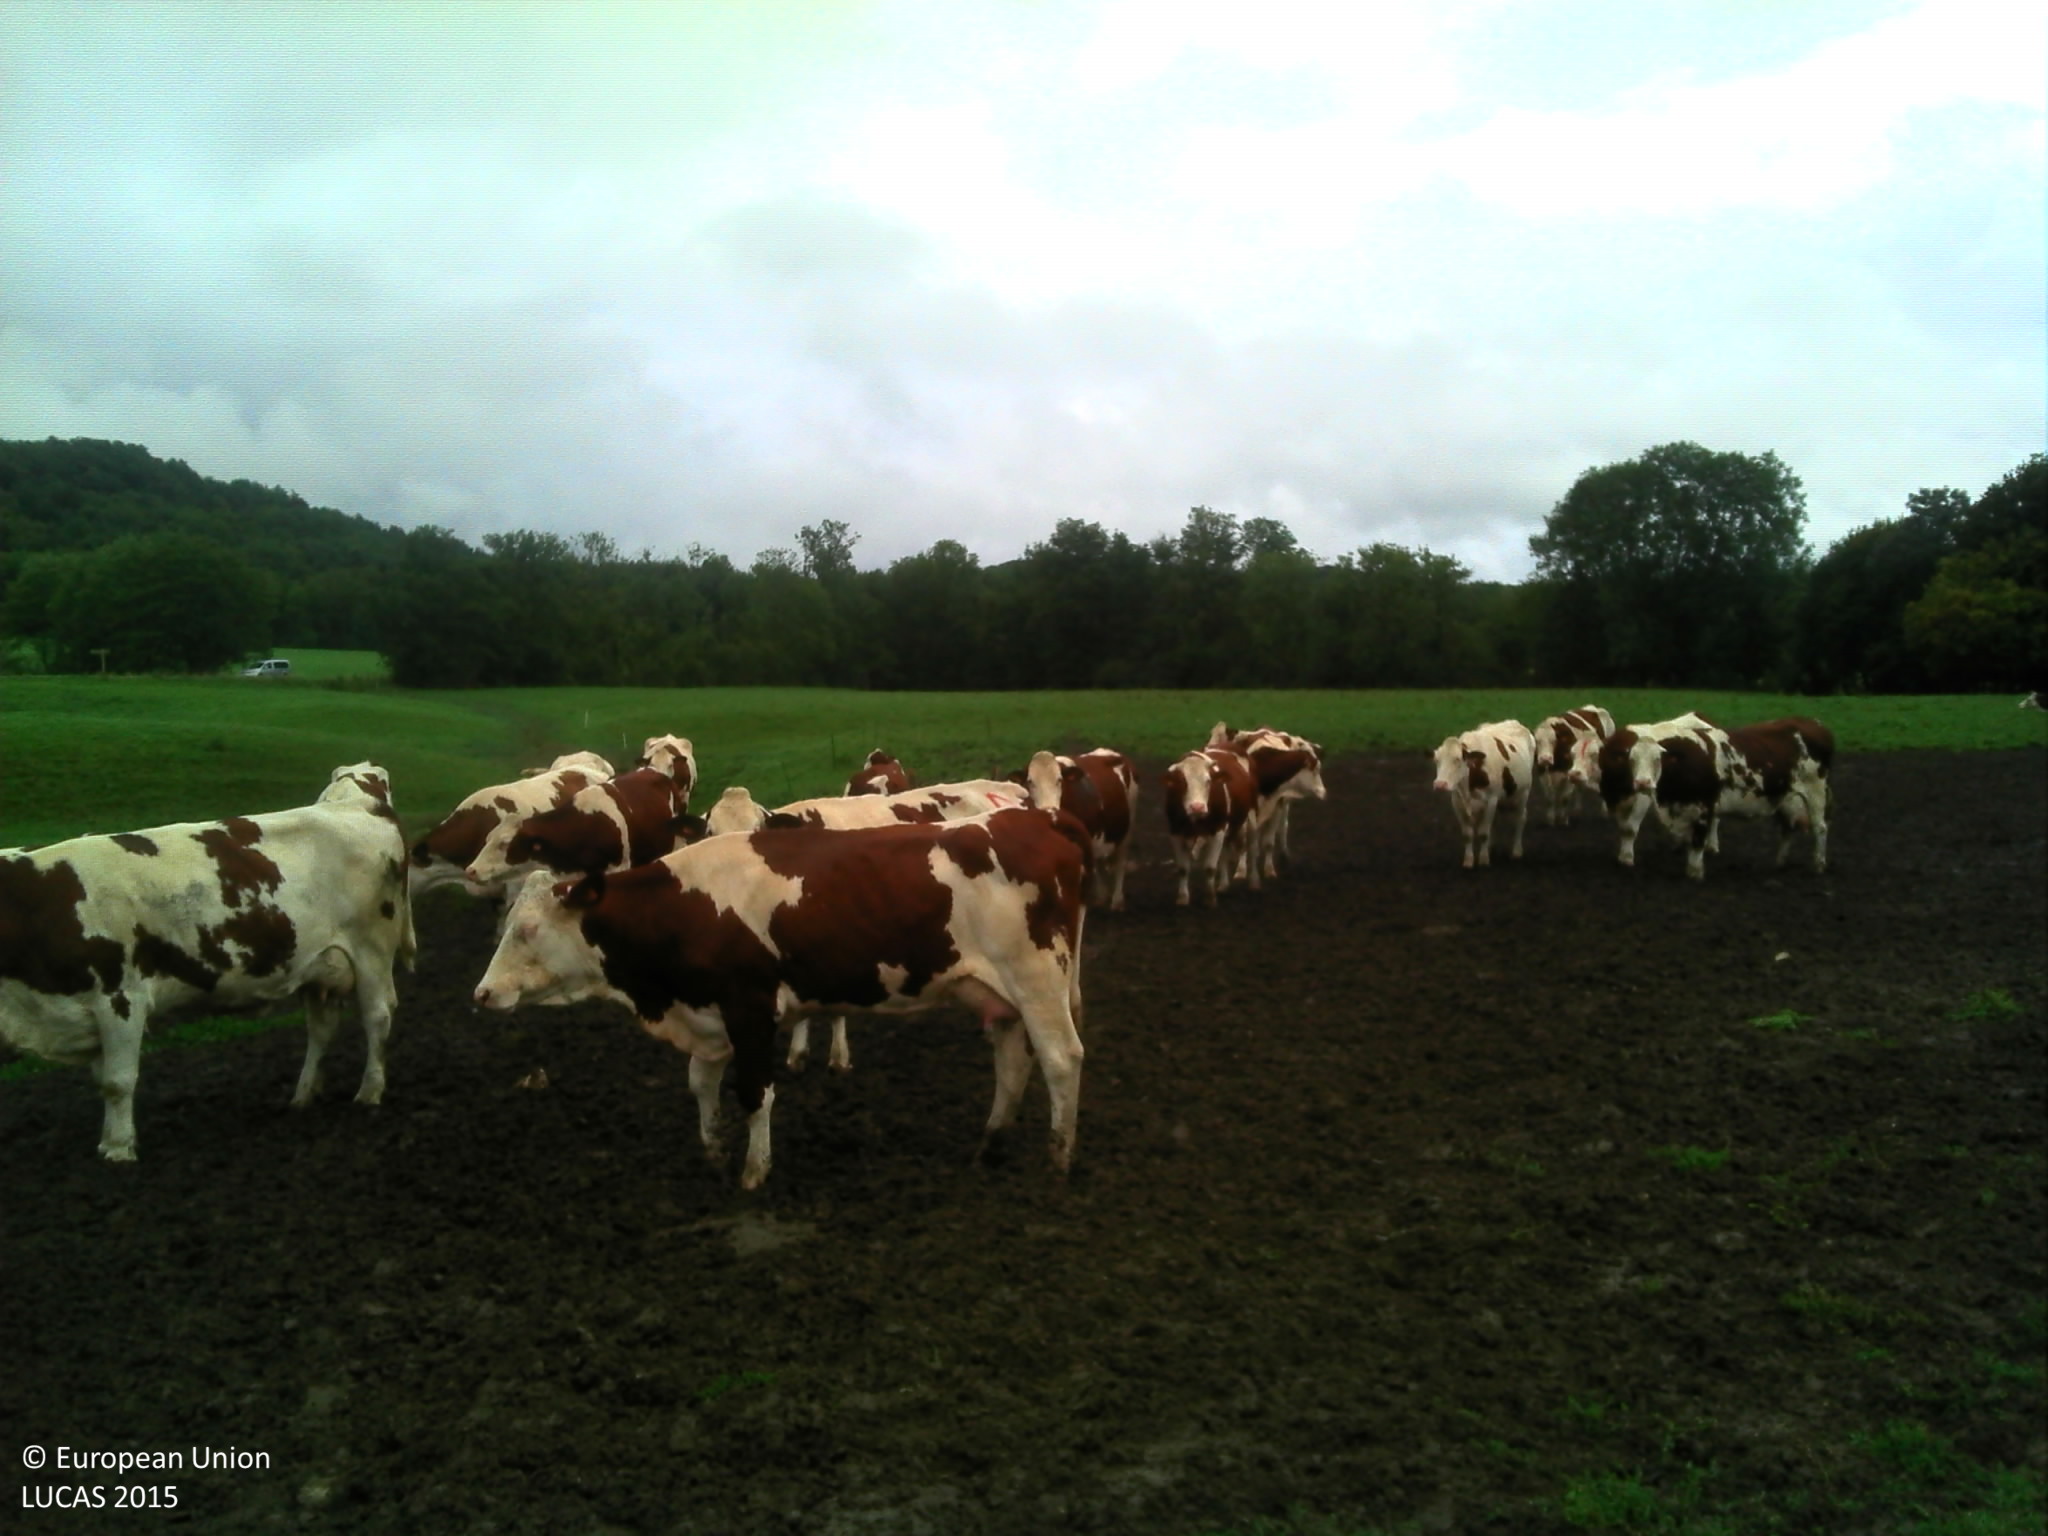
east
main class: Grassland
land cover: Grassland without tree/shrub cover
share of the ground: > 75 %
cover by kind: herbaceous plants 80 %, unconsolidated bare surface 20 %
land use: Agriculture (excluding fallow land and kitchen gardens)
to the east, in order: Grassland without tree/shrub cover; Fences; Paved roads, cycling and walking lanes; Grassland without tree/shrub cover; Electric lines; Grassland without tree/shrub cover; Fences; Grassland without tree/shrub cover; Electric lines; Fences; Grass margins
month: September
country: FR
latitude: 47.1818
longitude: 6.1091
